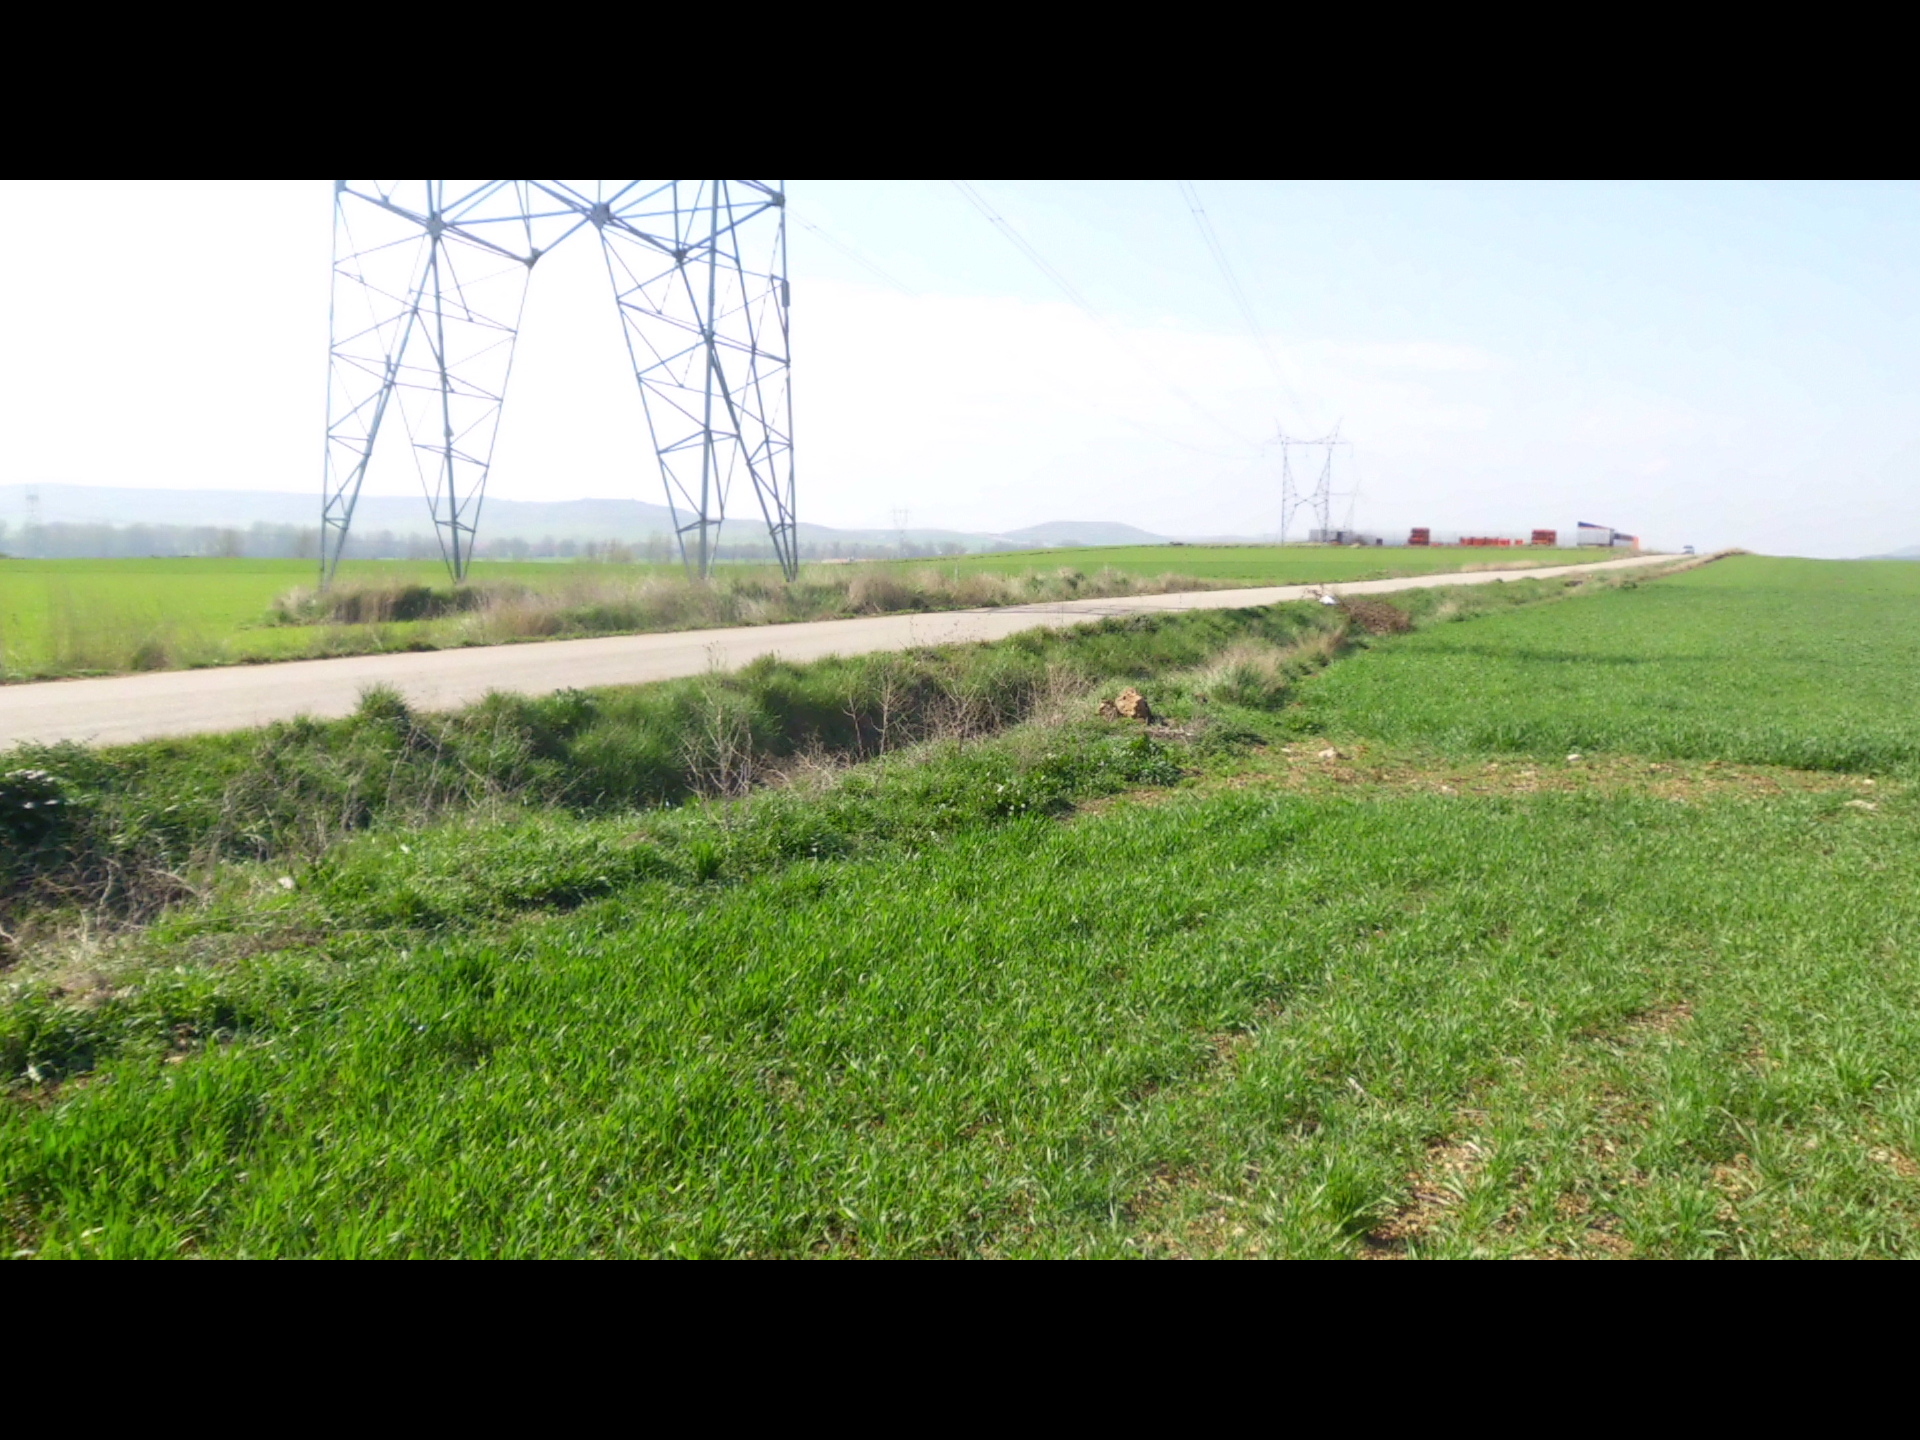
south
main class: Cropland
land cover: Common wheat
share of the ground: 50 - 75 %
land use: Agriculture (excluding fallow land and kitchen gardens)
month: April
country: ES
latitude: 42.4332
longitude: -3.6877
